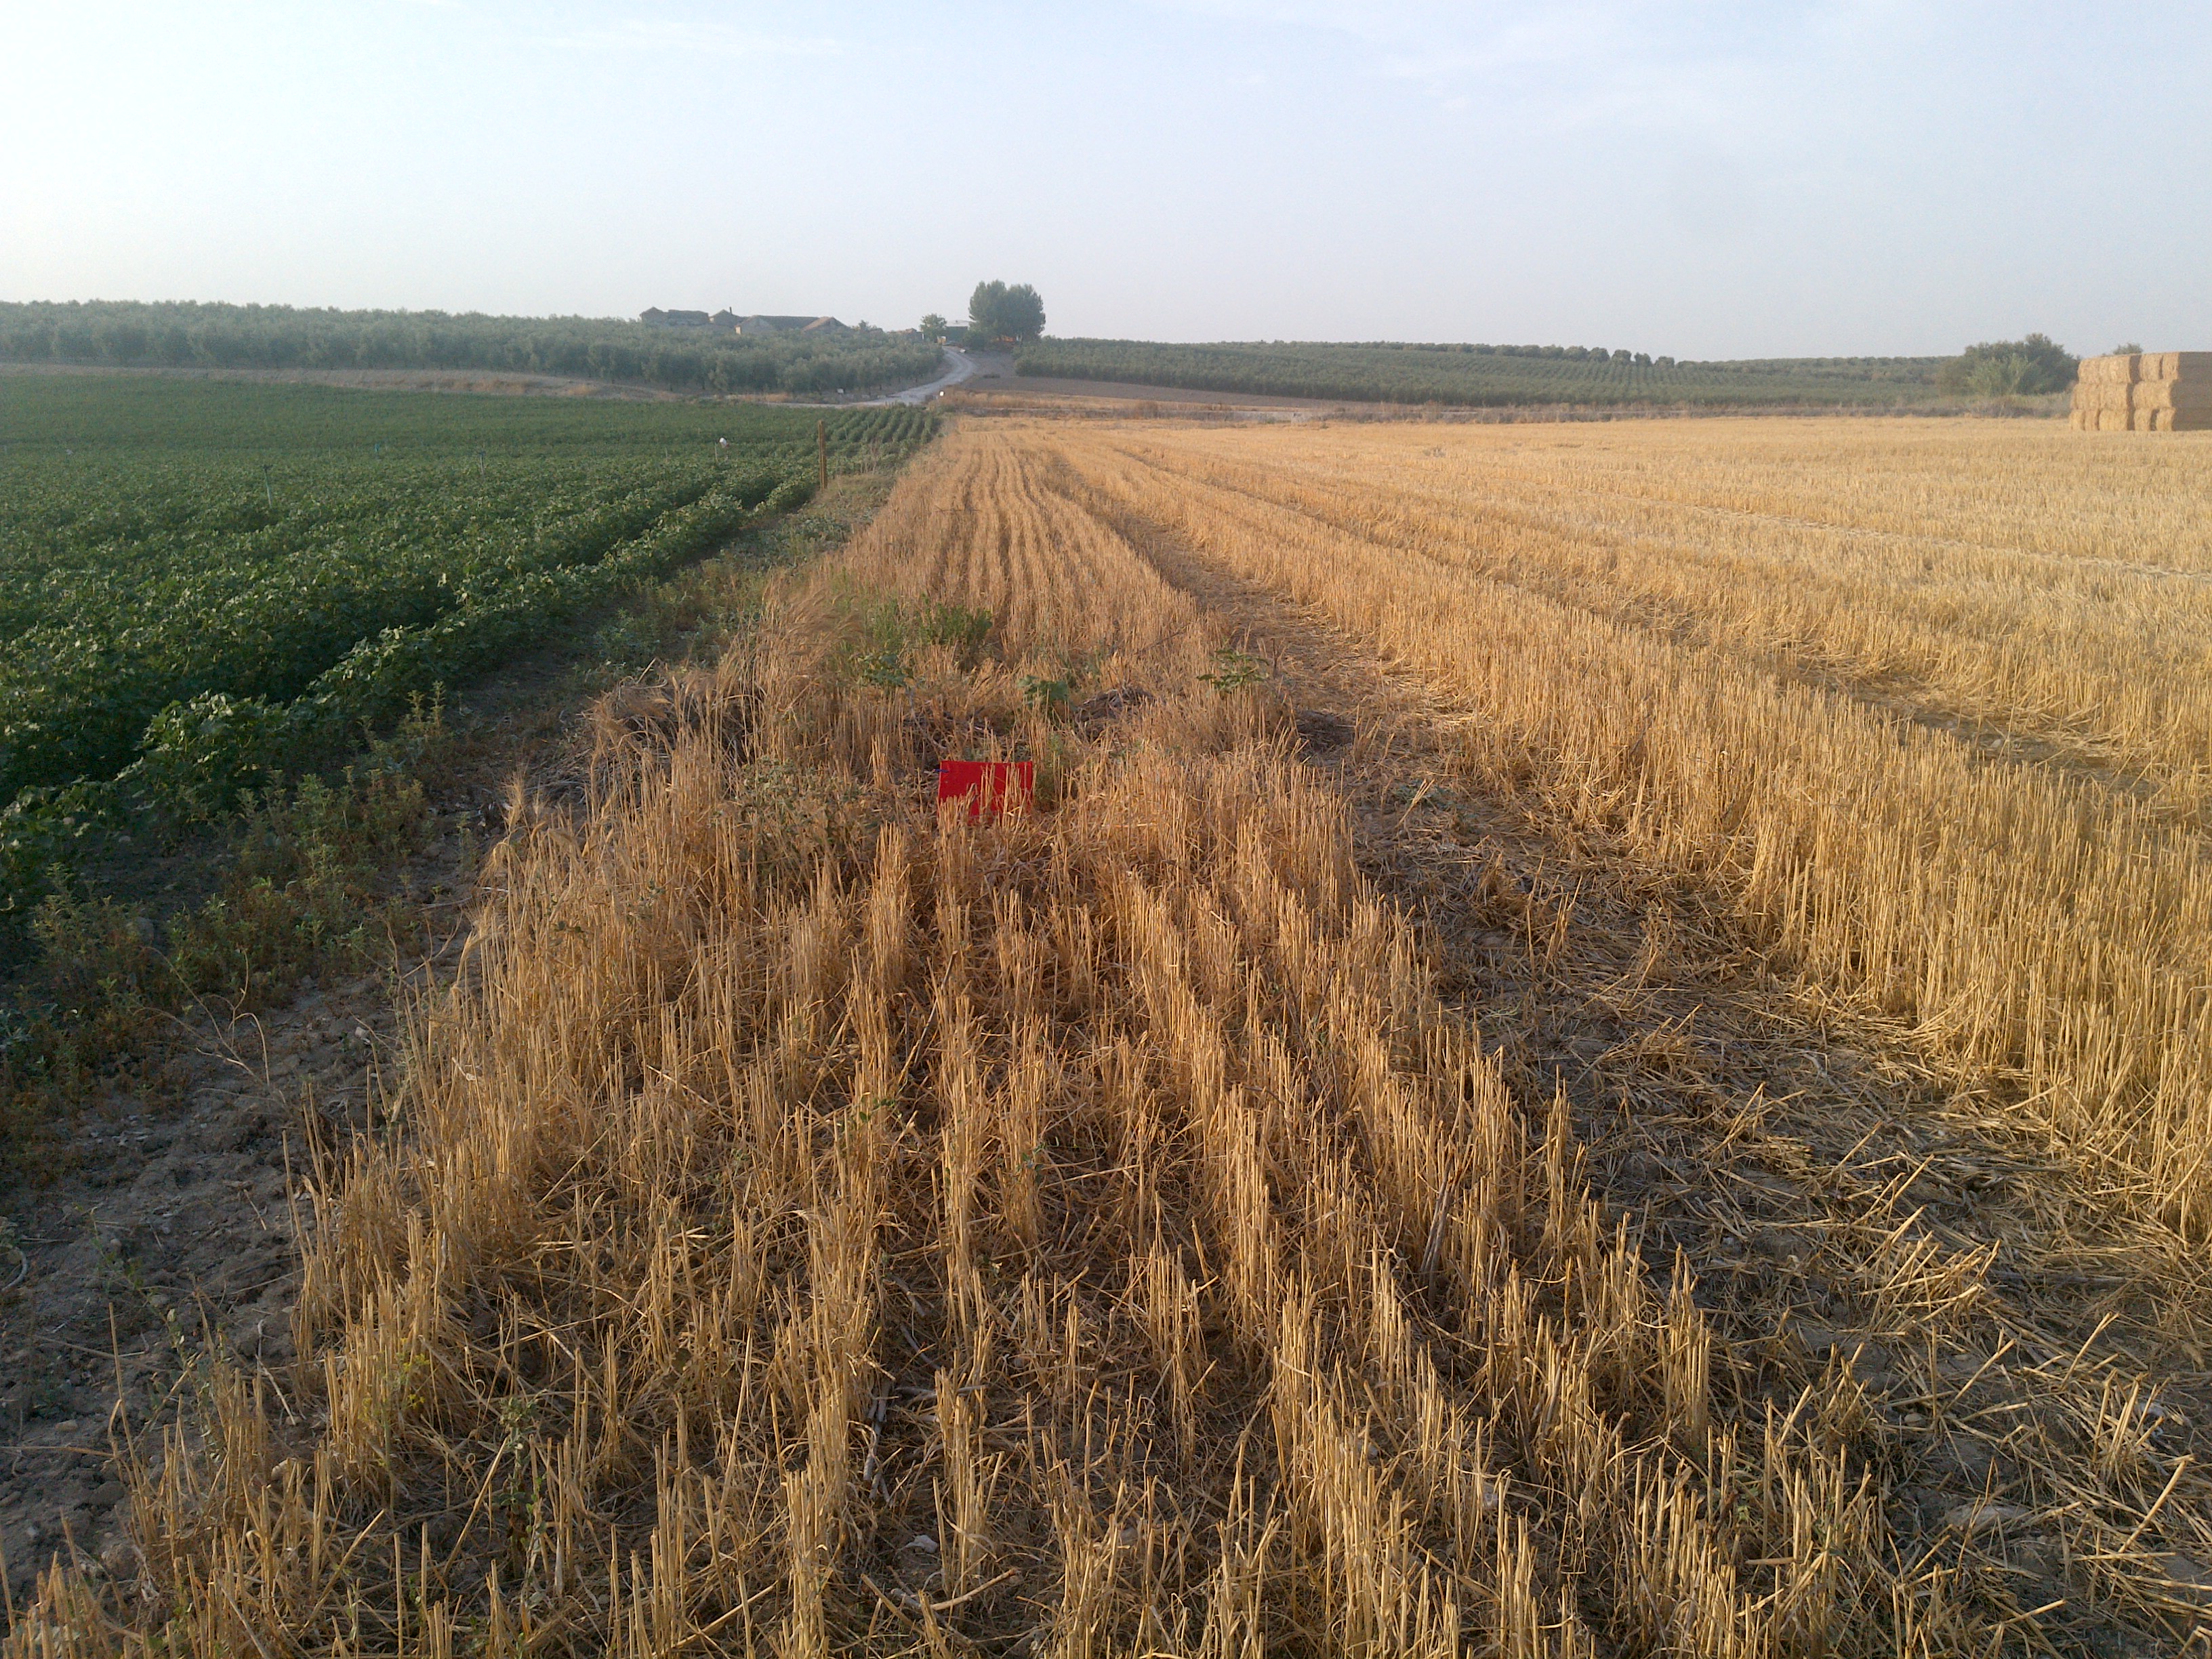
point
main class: Cropland
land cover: Durum wheat
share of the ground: < 10 %
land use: Agriculture (excluding fallow land and kitchen gardens)
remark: Harvested field
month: July
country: ES
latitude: 37.5108
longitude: -4.8633
